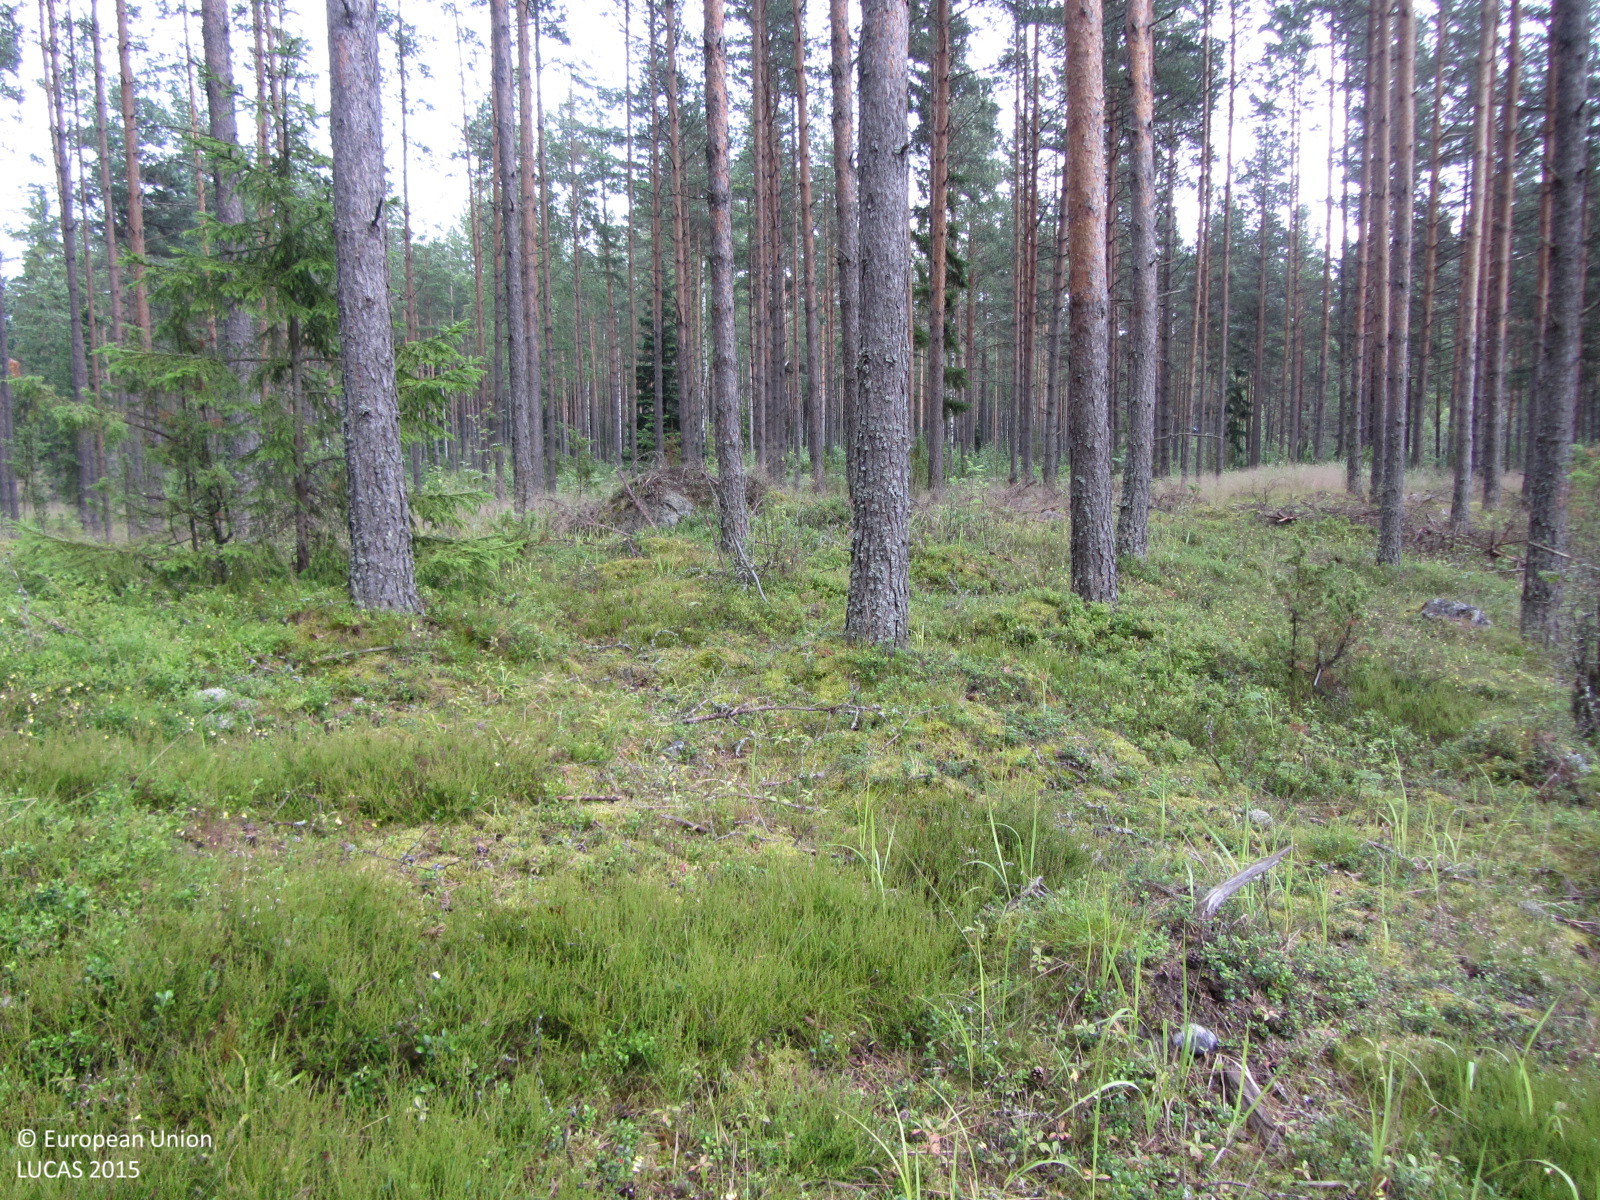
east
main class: Shrubland
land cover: Shrubland with sparse tree cover
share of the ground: > 75 %
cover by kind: shrubs 90 %, broadleaved forest trees 5 %, herbaceous plants 5 %
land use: Electricity, gas and thermal power distribution
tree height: < 5 m
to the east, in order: Shrubland with sparse tree cover; Pine dominated coniferous woodland; Paved roads, cycling and walking lanes; Ditches and canals; Pine dominated mixed woodland; Tracks; Pine dominated coniferous woodland
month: July
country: FI
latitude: 60.0756
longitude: 24.2474
